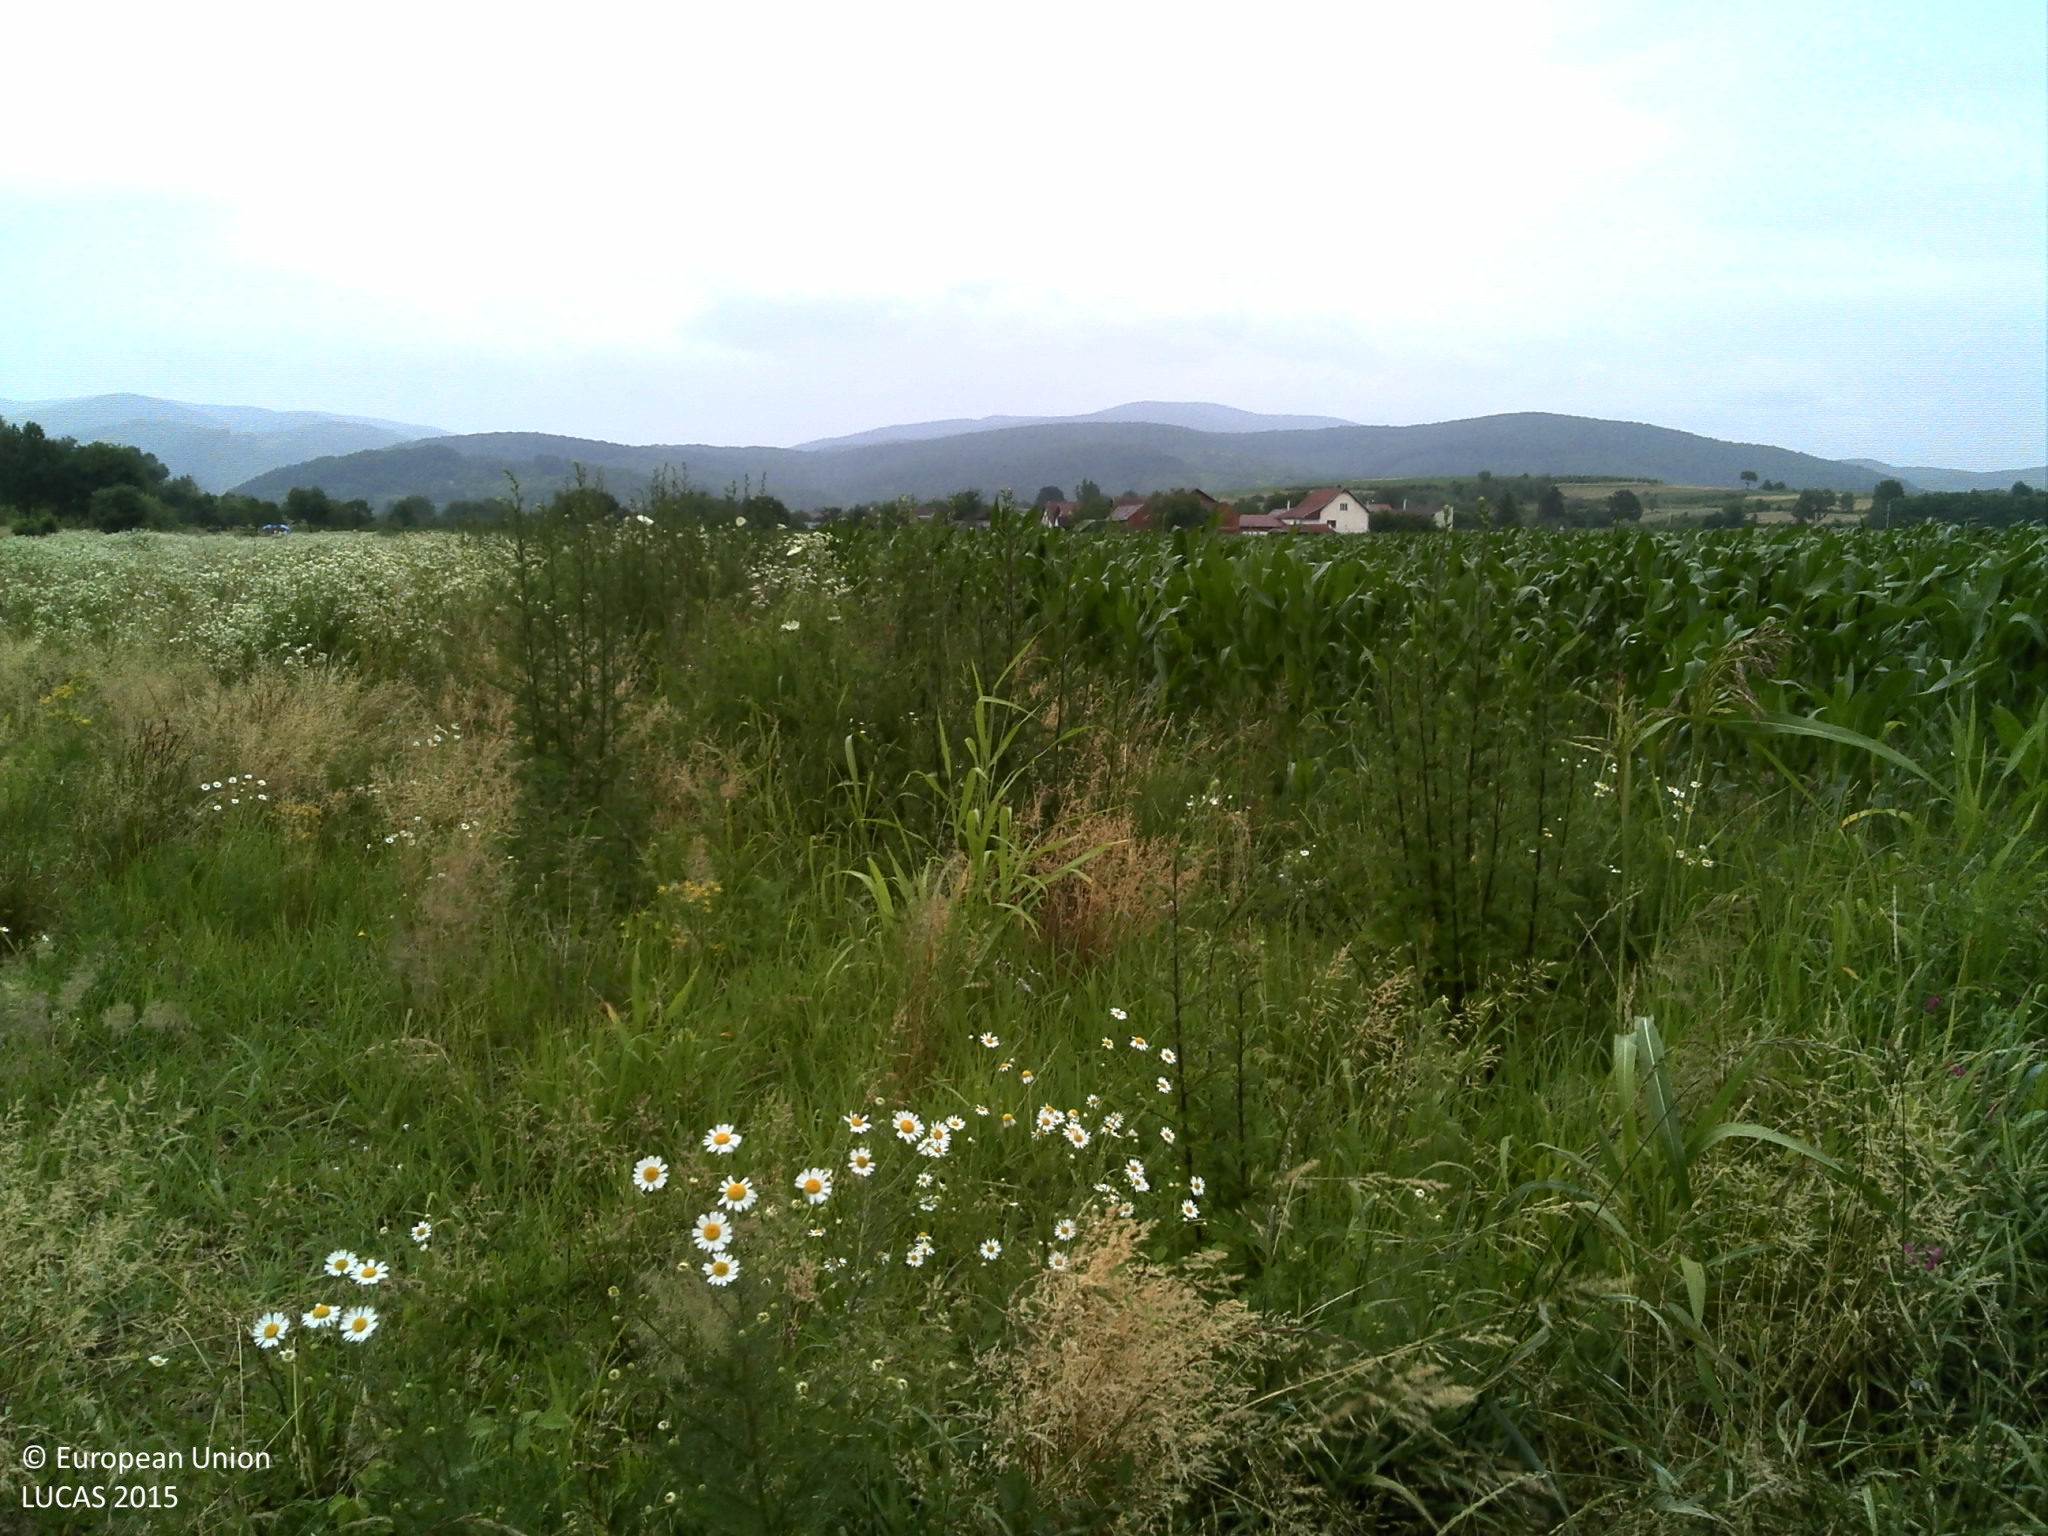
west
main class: Grassland
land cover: Spontaneously vegetated surfaces
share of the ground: > 75 %
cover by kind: herbaceous plants 100 %
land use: Agriculture (excluding fallow land and kitchen gardens)
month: June
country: HR
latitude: 45.2551
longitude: 17.5059
